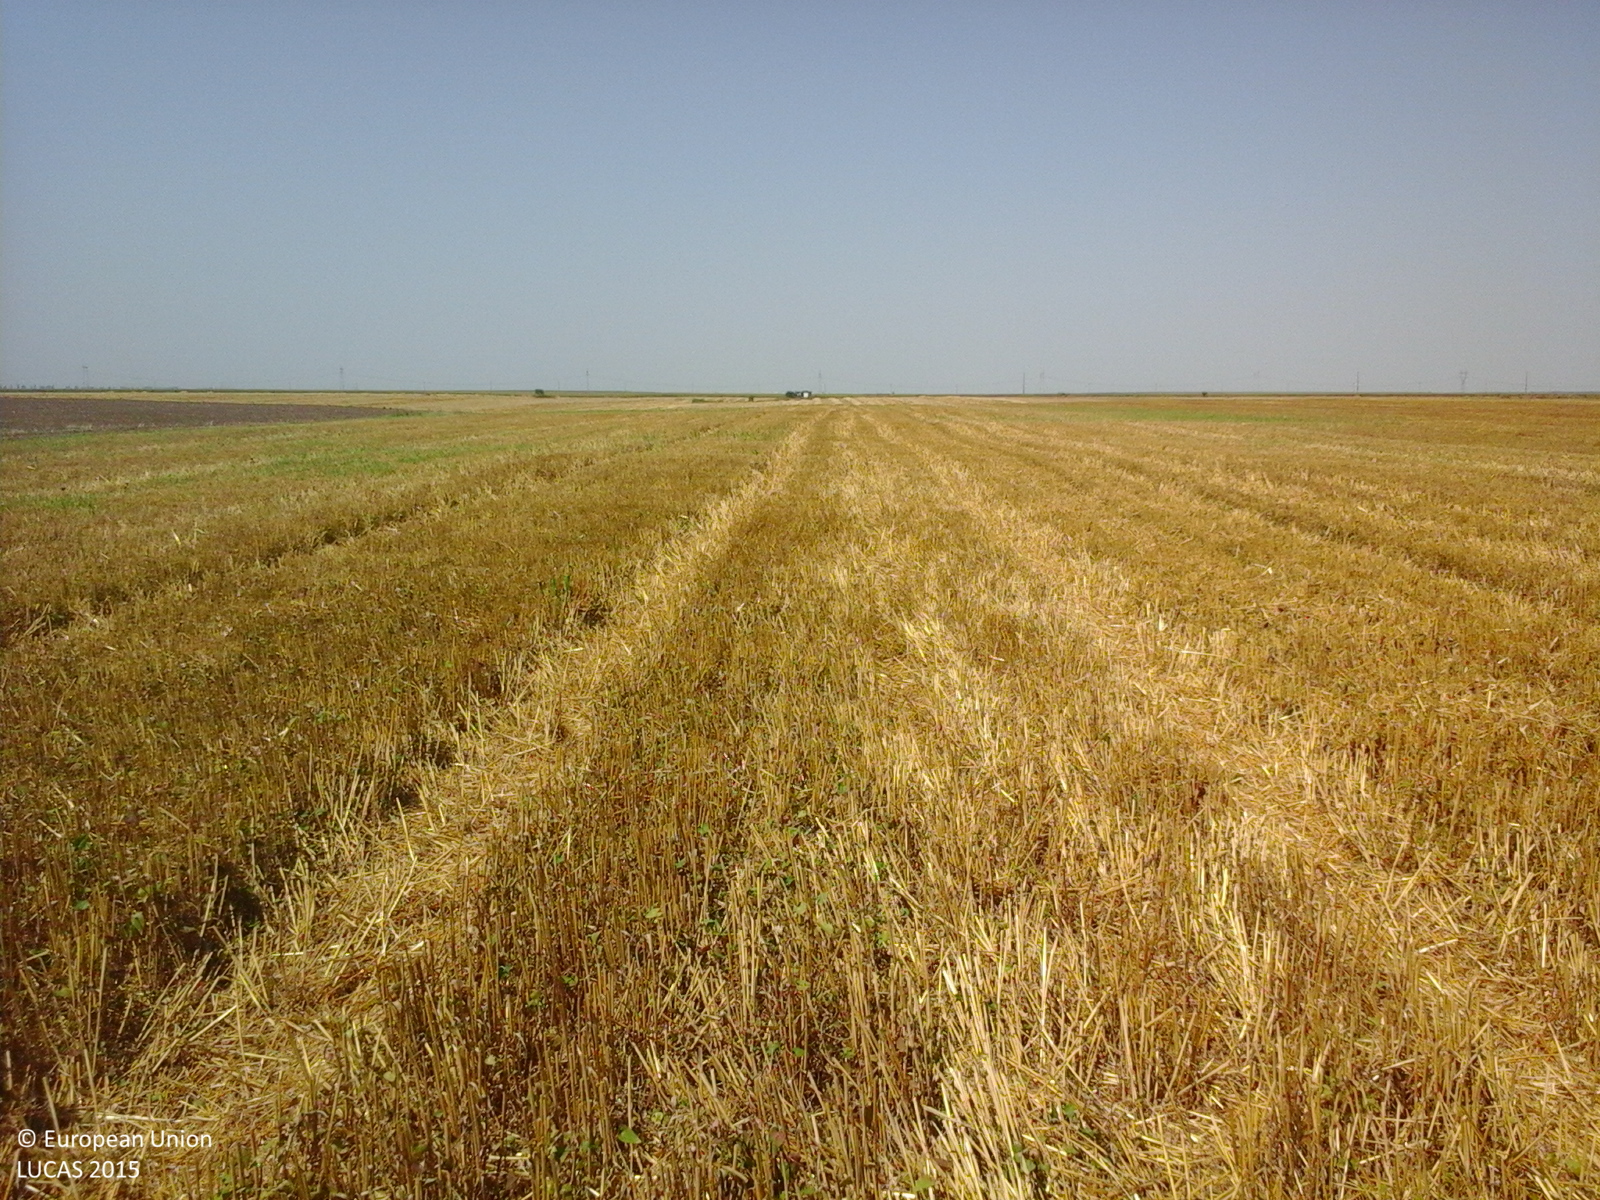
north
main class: Cropland
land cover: Common wheat
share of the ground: < 10 %
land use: Agriculture (excluding fallow land and kitchen gardens)
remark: Harvested field
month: July
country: RO
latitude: 44.6256
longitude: 27.3444
